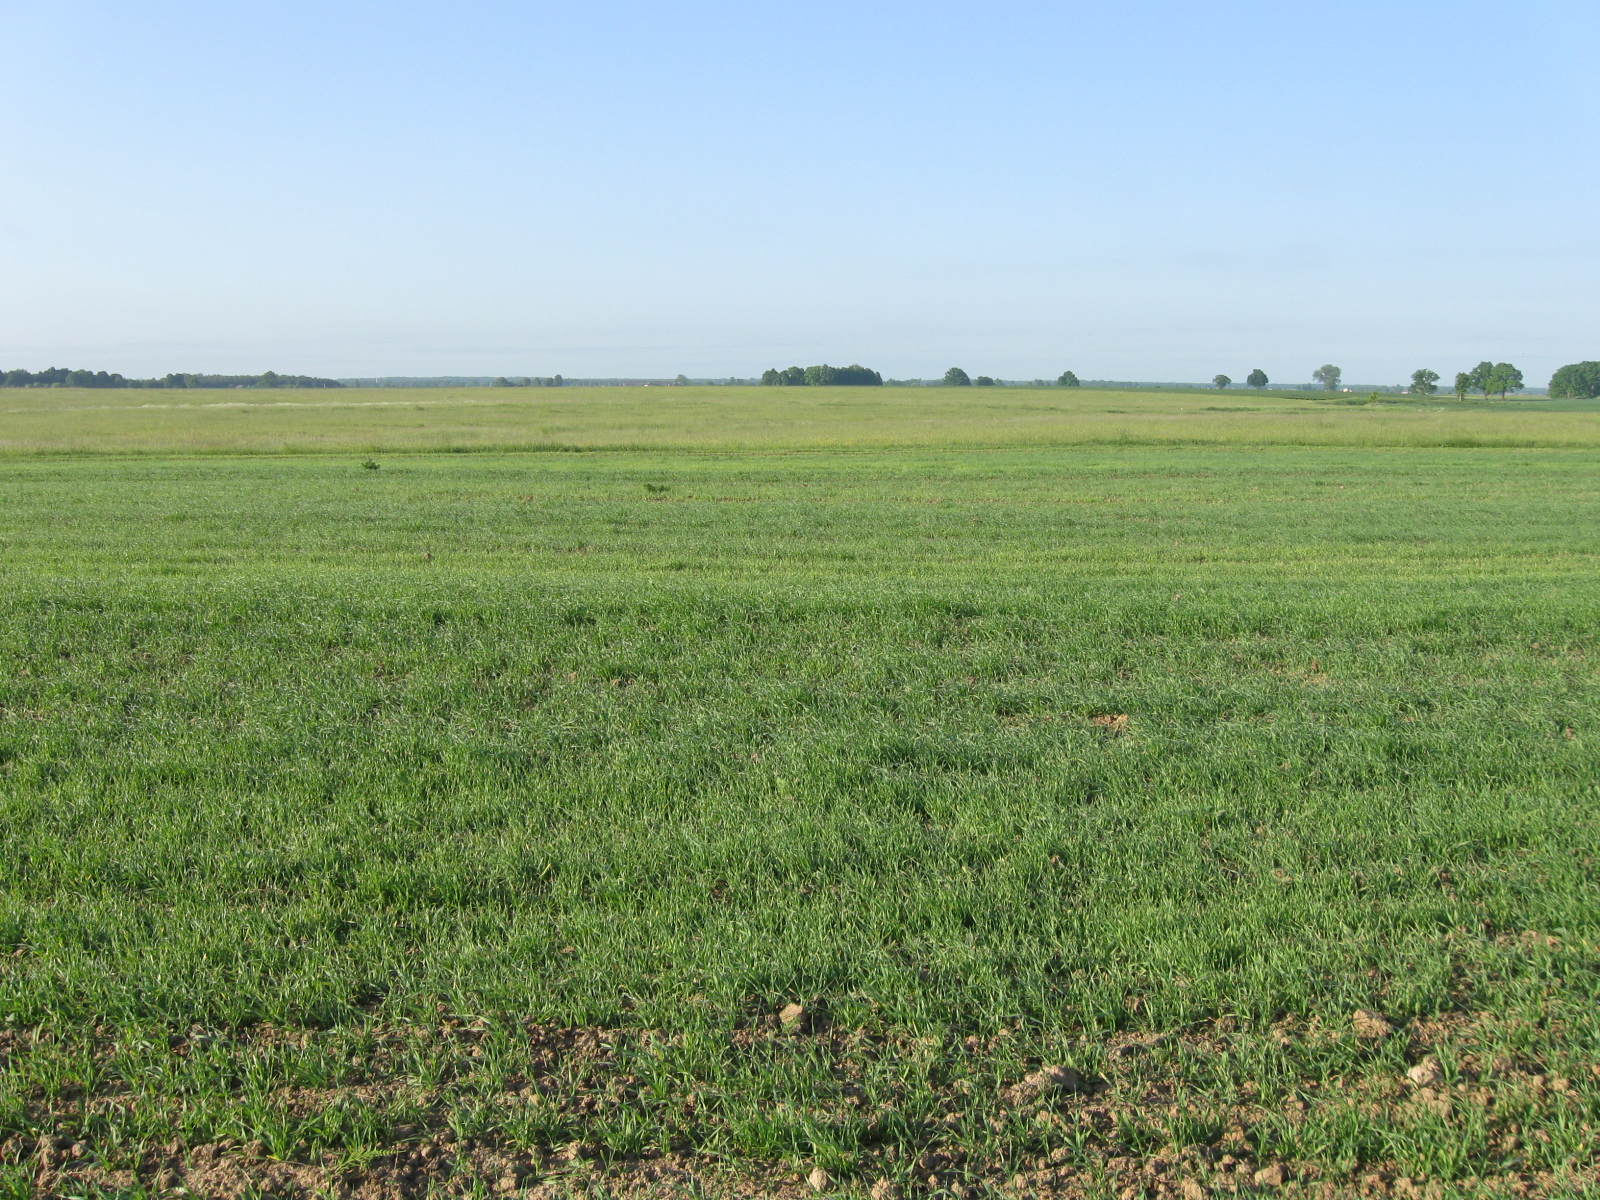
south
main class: Cropland
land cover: Barley
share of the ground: > 75 %
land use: Agriculture (excluding fallow land and kitchen gardens)
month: June
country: LT
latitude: 54.5179
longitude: 23.8532
